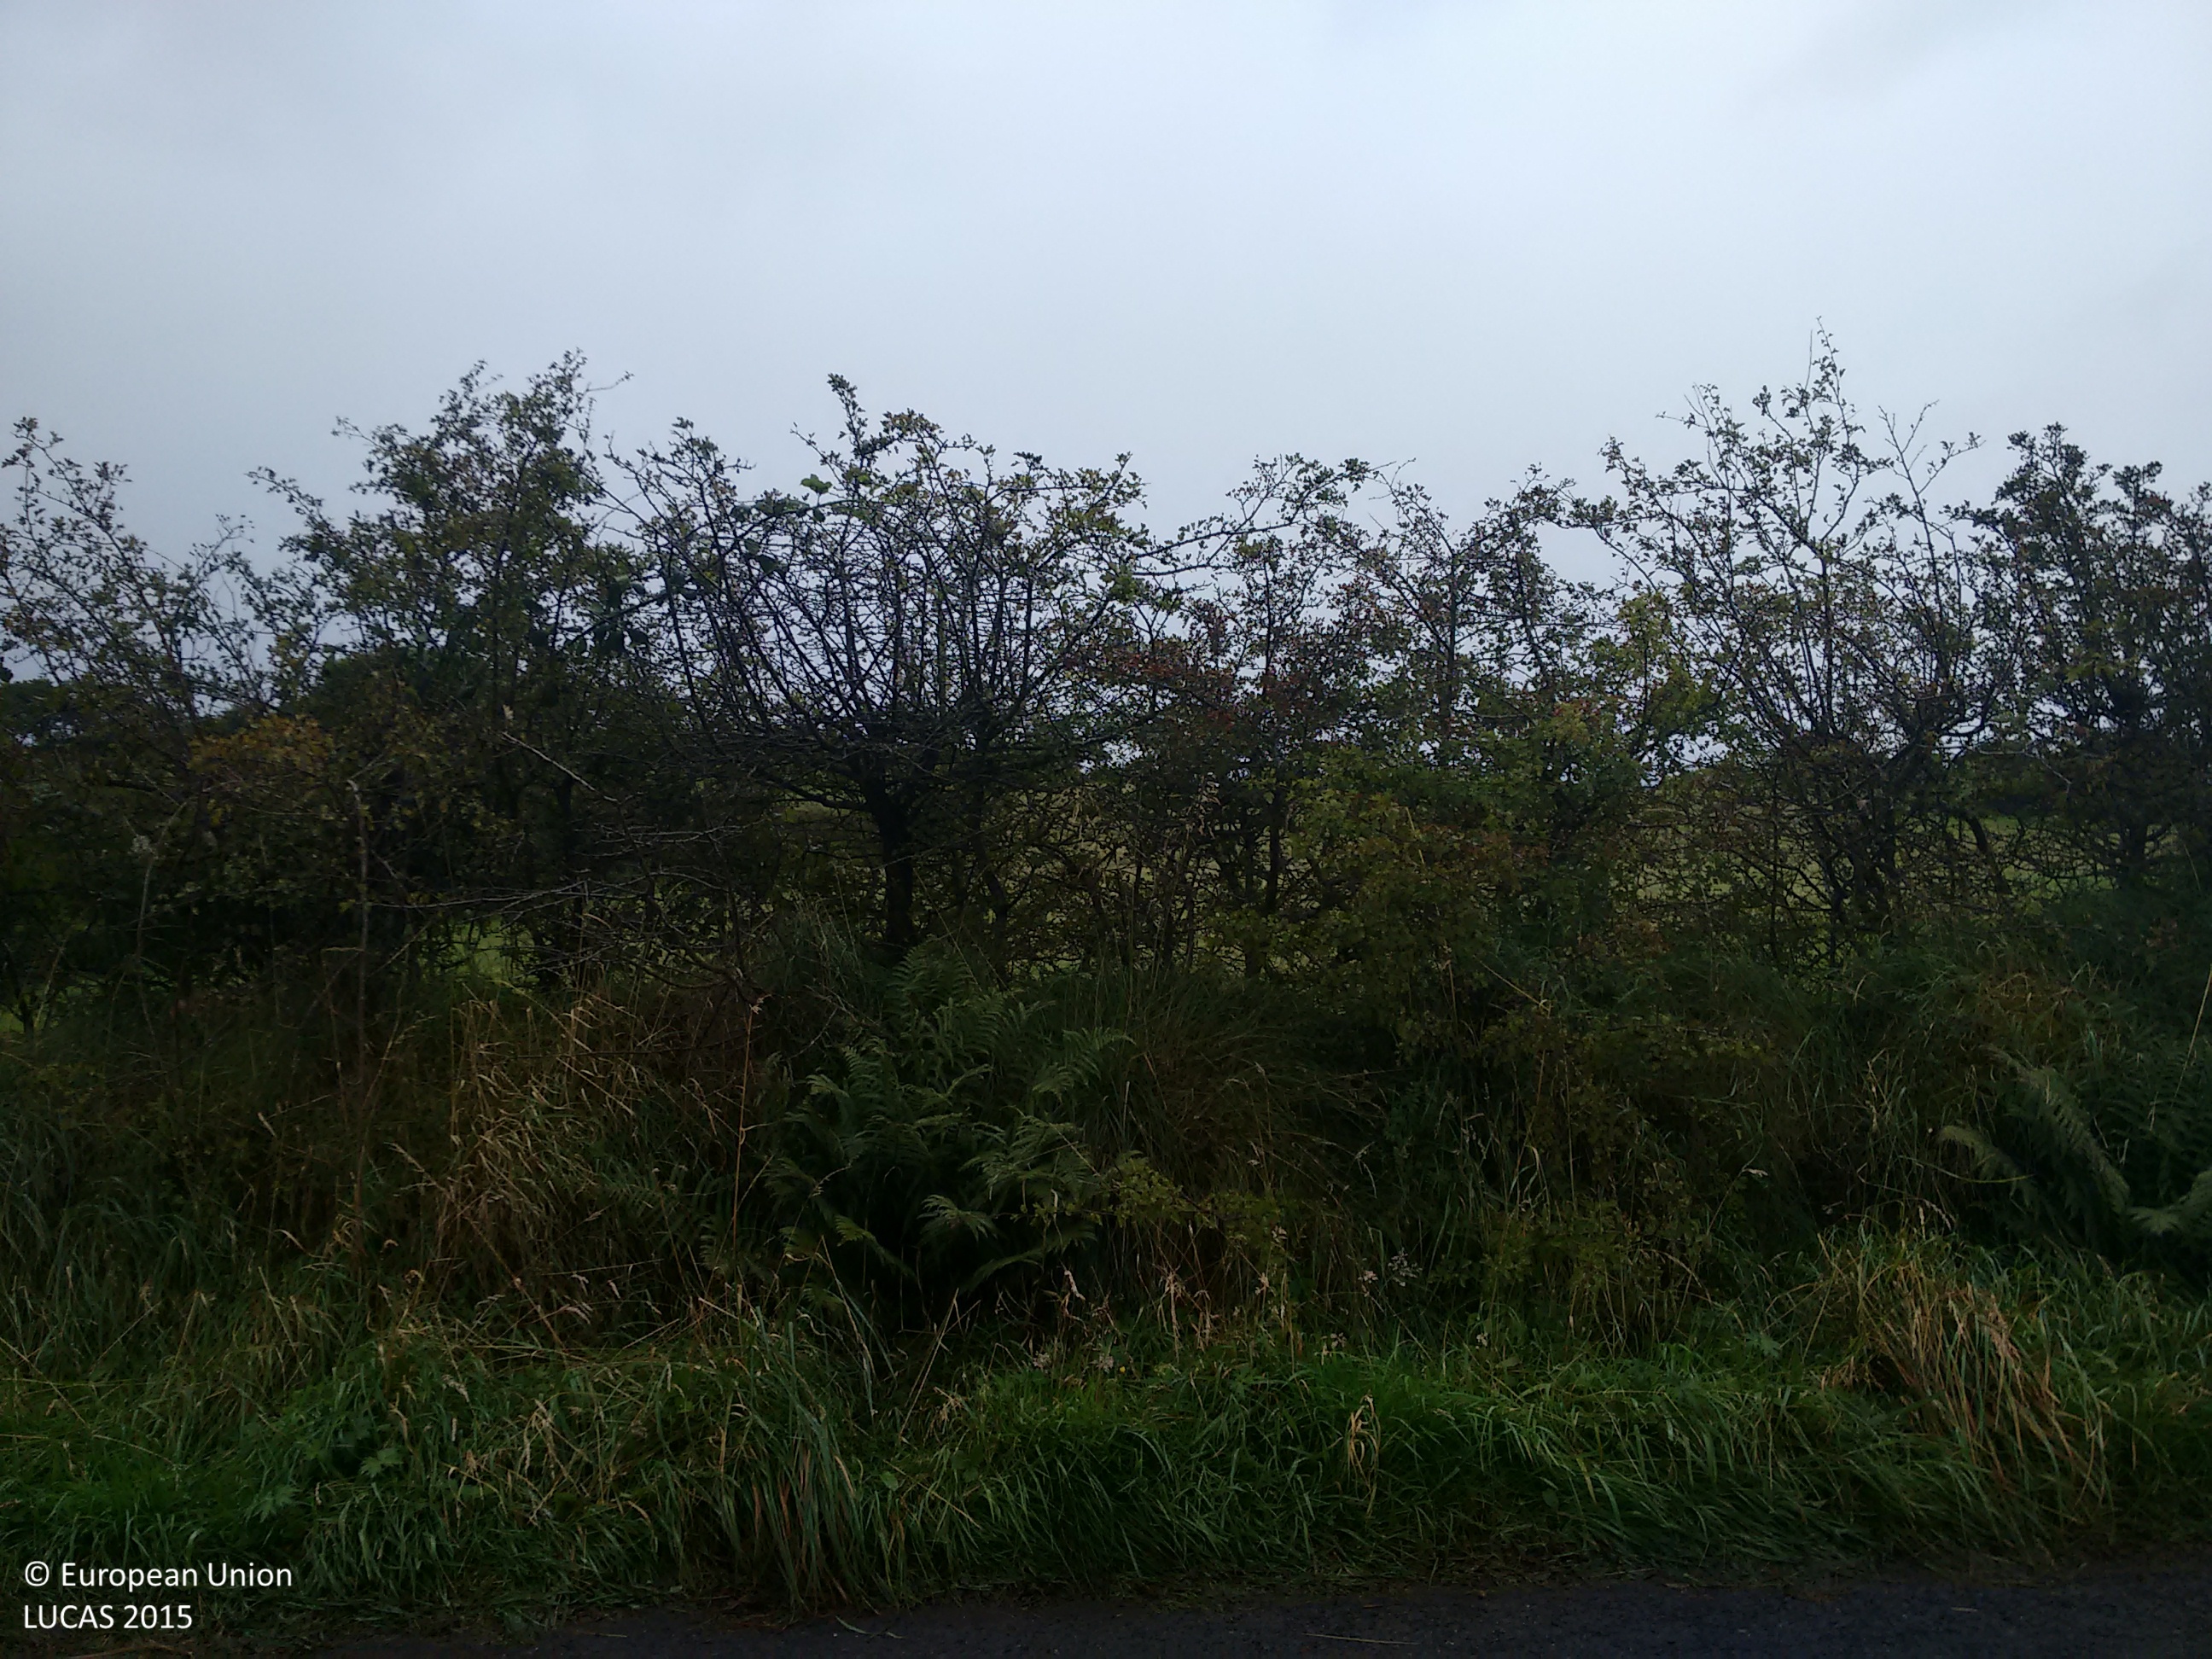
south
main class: Grassland
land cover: Grassland without tree/shrub cover
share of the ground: > 75 %
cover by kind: herbaceous plants 100 %
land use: Agriculture (excluding fallow land and kitchen gardens)
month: September
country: GB
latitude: 54.7571
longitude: -5.8141
